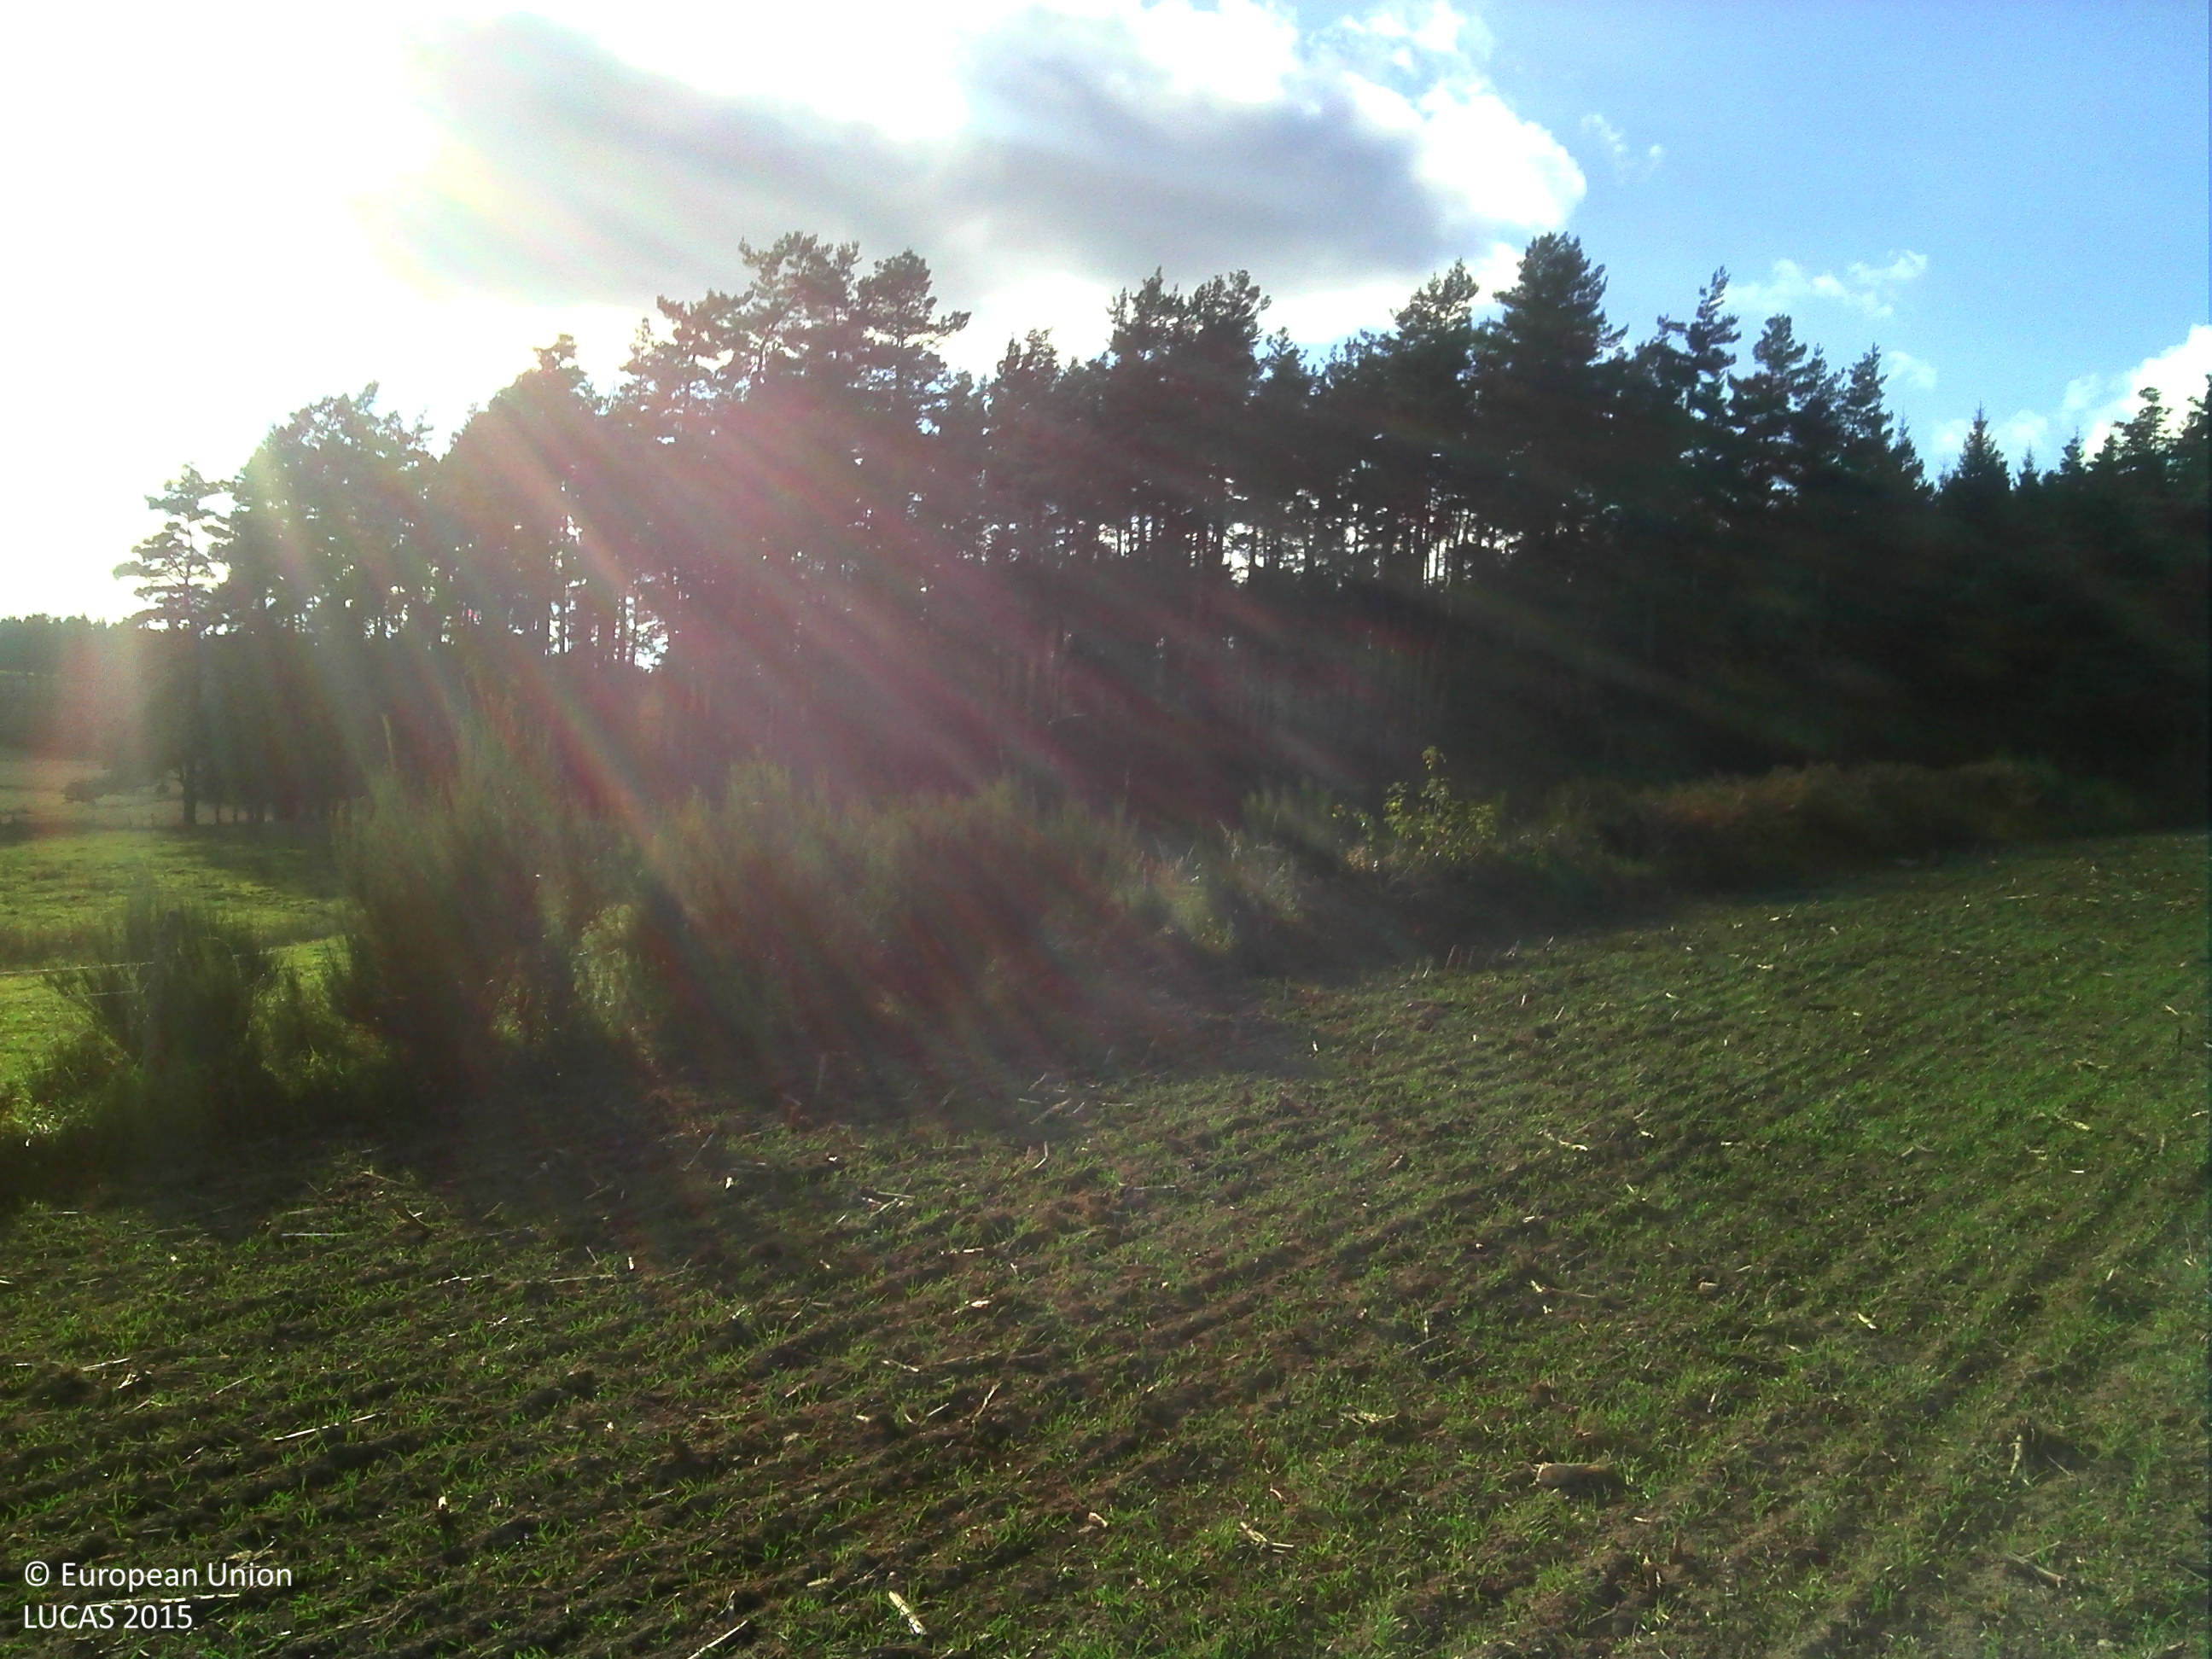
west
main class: Cropland
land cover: Temporary grasslands
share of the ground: 10 - 25 %
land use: Agriculture (excluding fallow land and kitchen gardens)
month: November
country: FR
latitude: 45.2498
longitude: 3.7983
